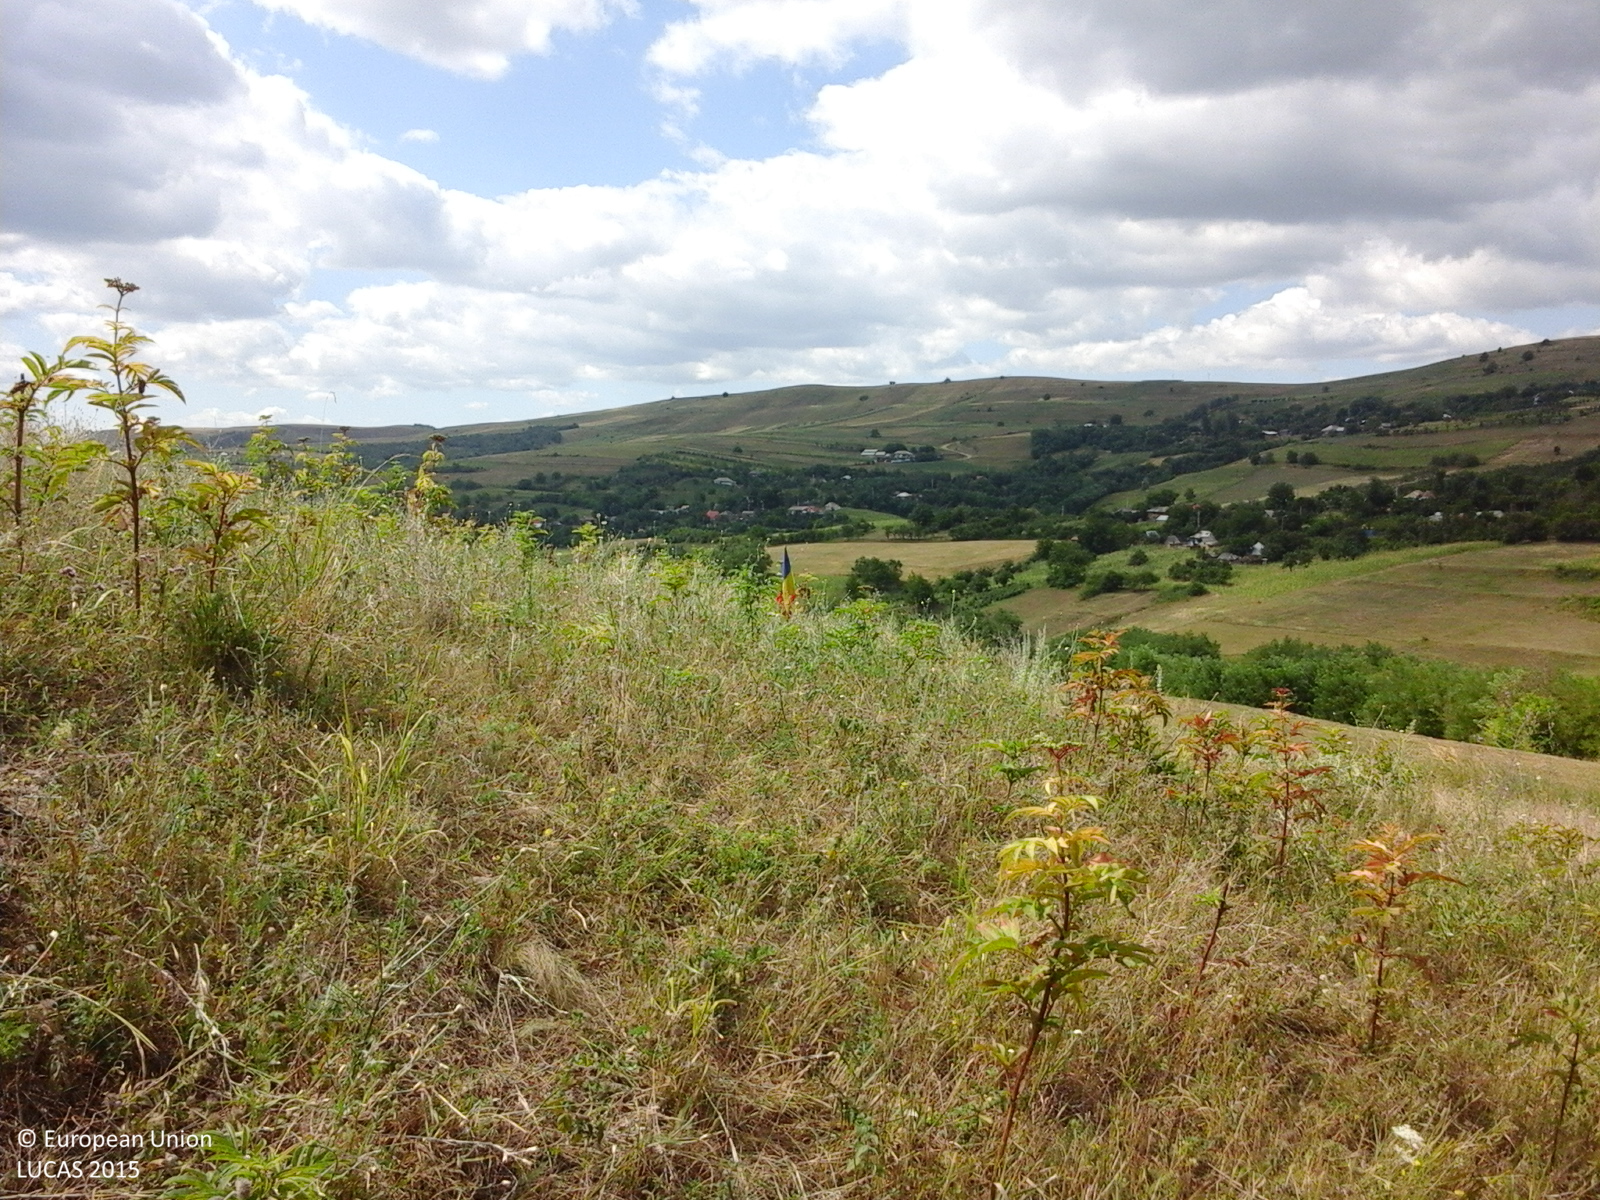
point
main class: Grassland
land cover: Grassland without tree/shrub cover
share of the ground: > 75 %
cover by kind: herbaceous plants 100 %
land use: Agriculture (excluding fallow land and kitchen gardens)
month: July
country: RO
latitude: 46.4289
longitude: 27.3482
